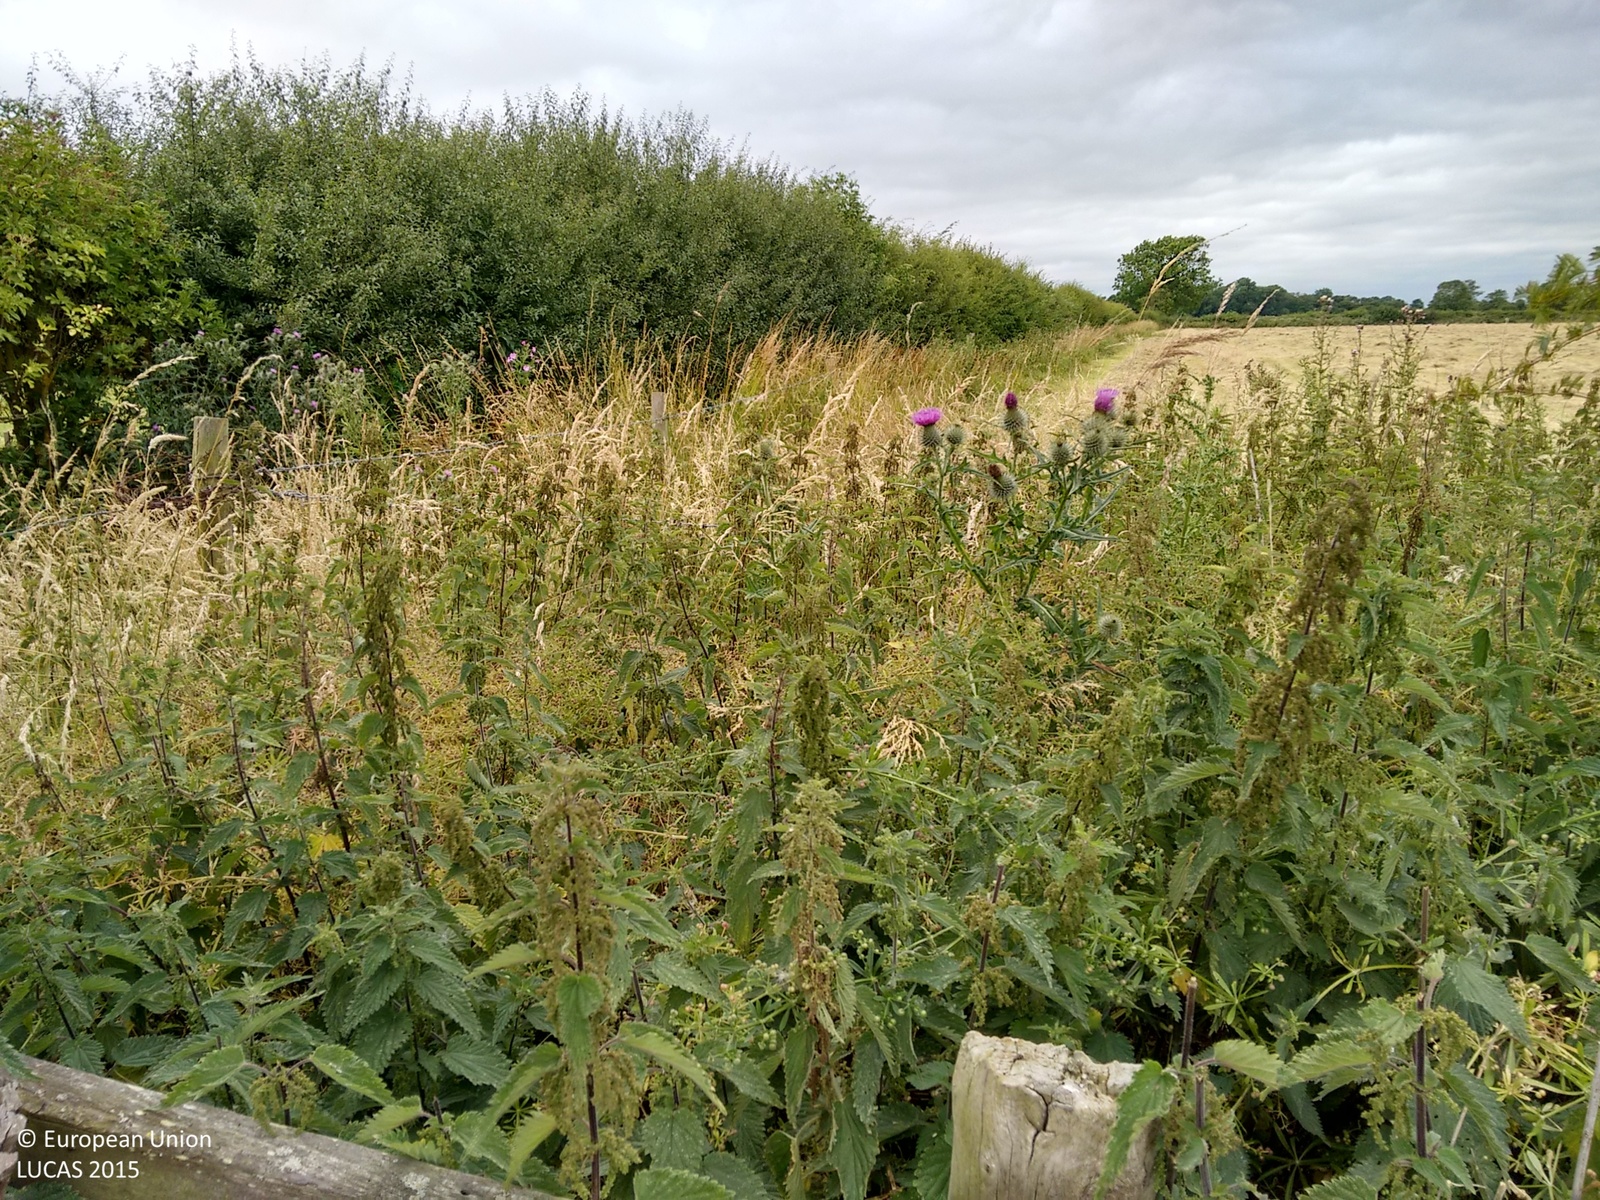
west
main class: Grassland
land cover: Grassland without tree/shrub cover
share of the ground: > 75 %
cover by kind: herbaceous plants 100 %
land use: Agriculture (excluding fallow land and kitchen gardens)
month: July
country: GB
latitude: 52.5062
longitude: -0.9309
